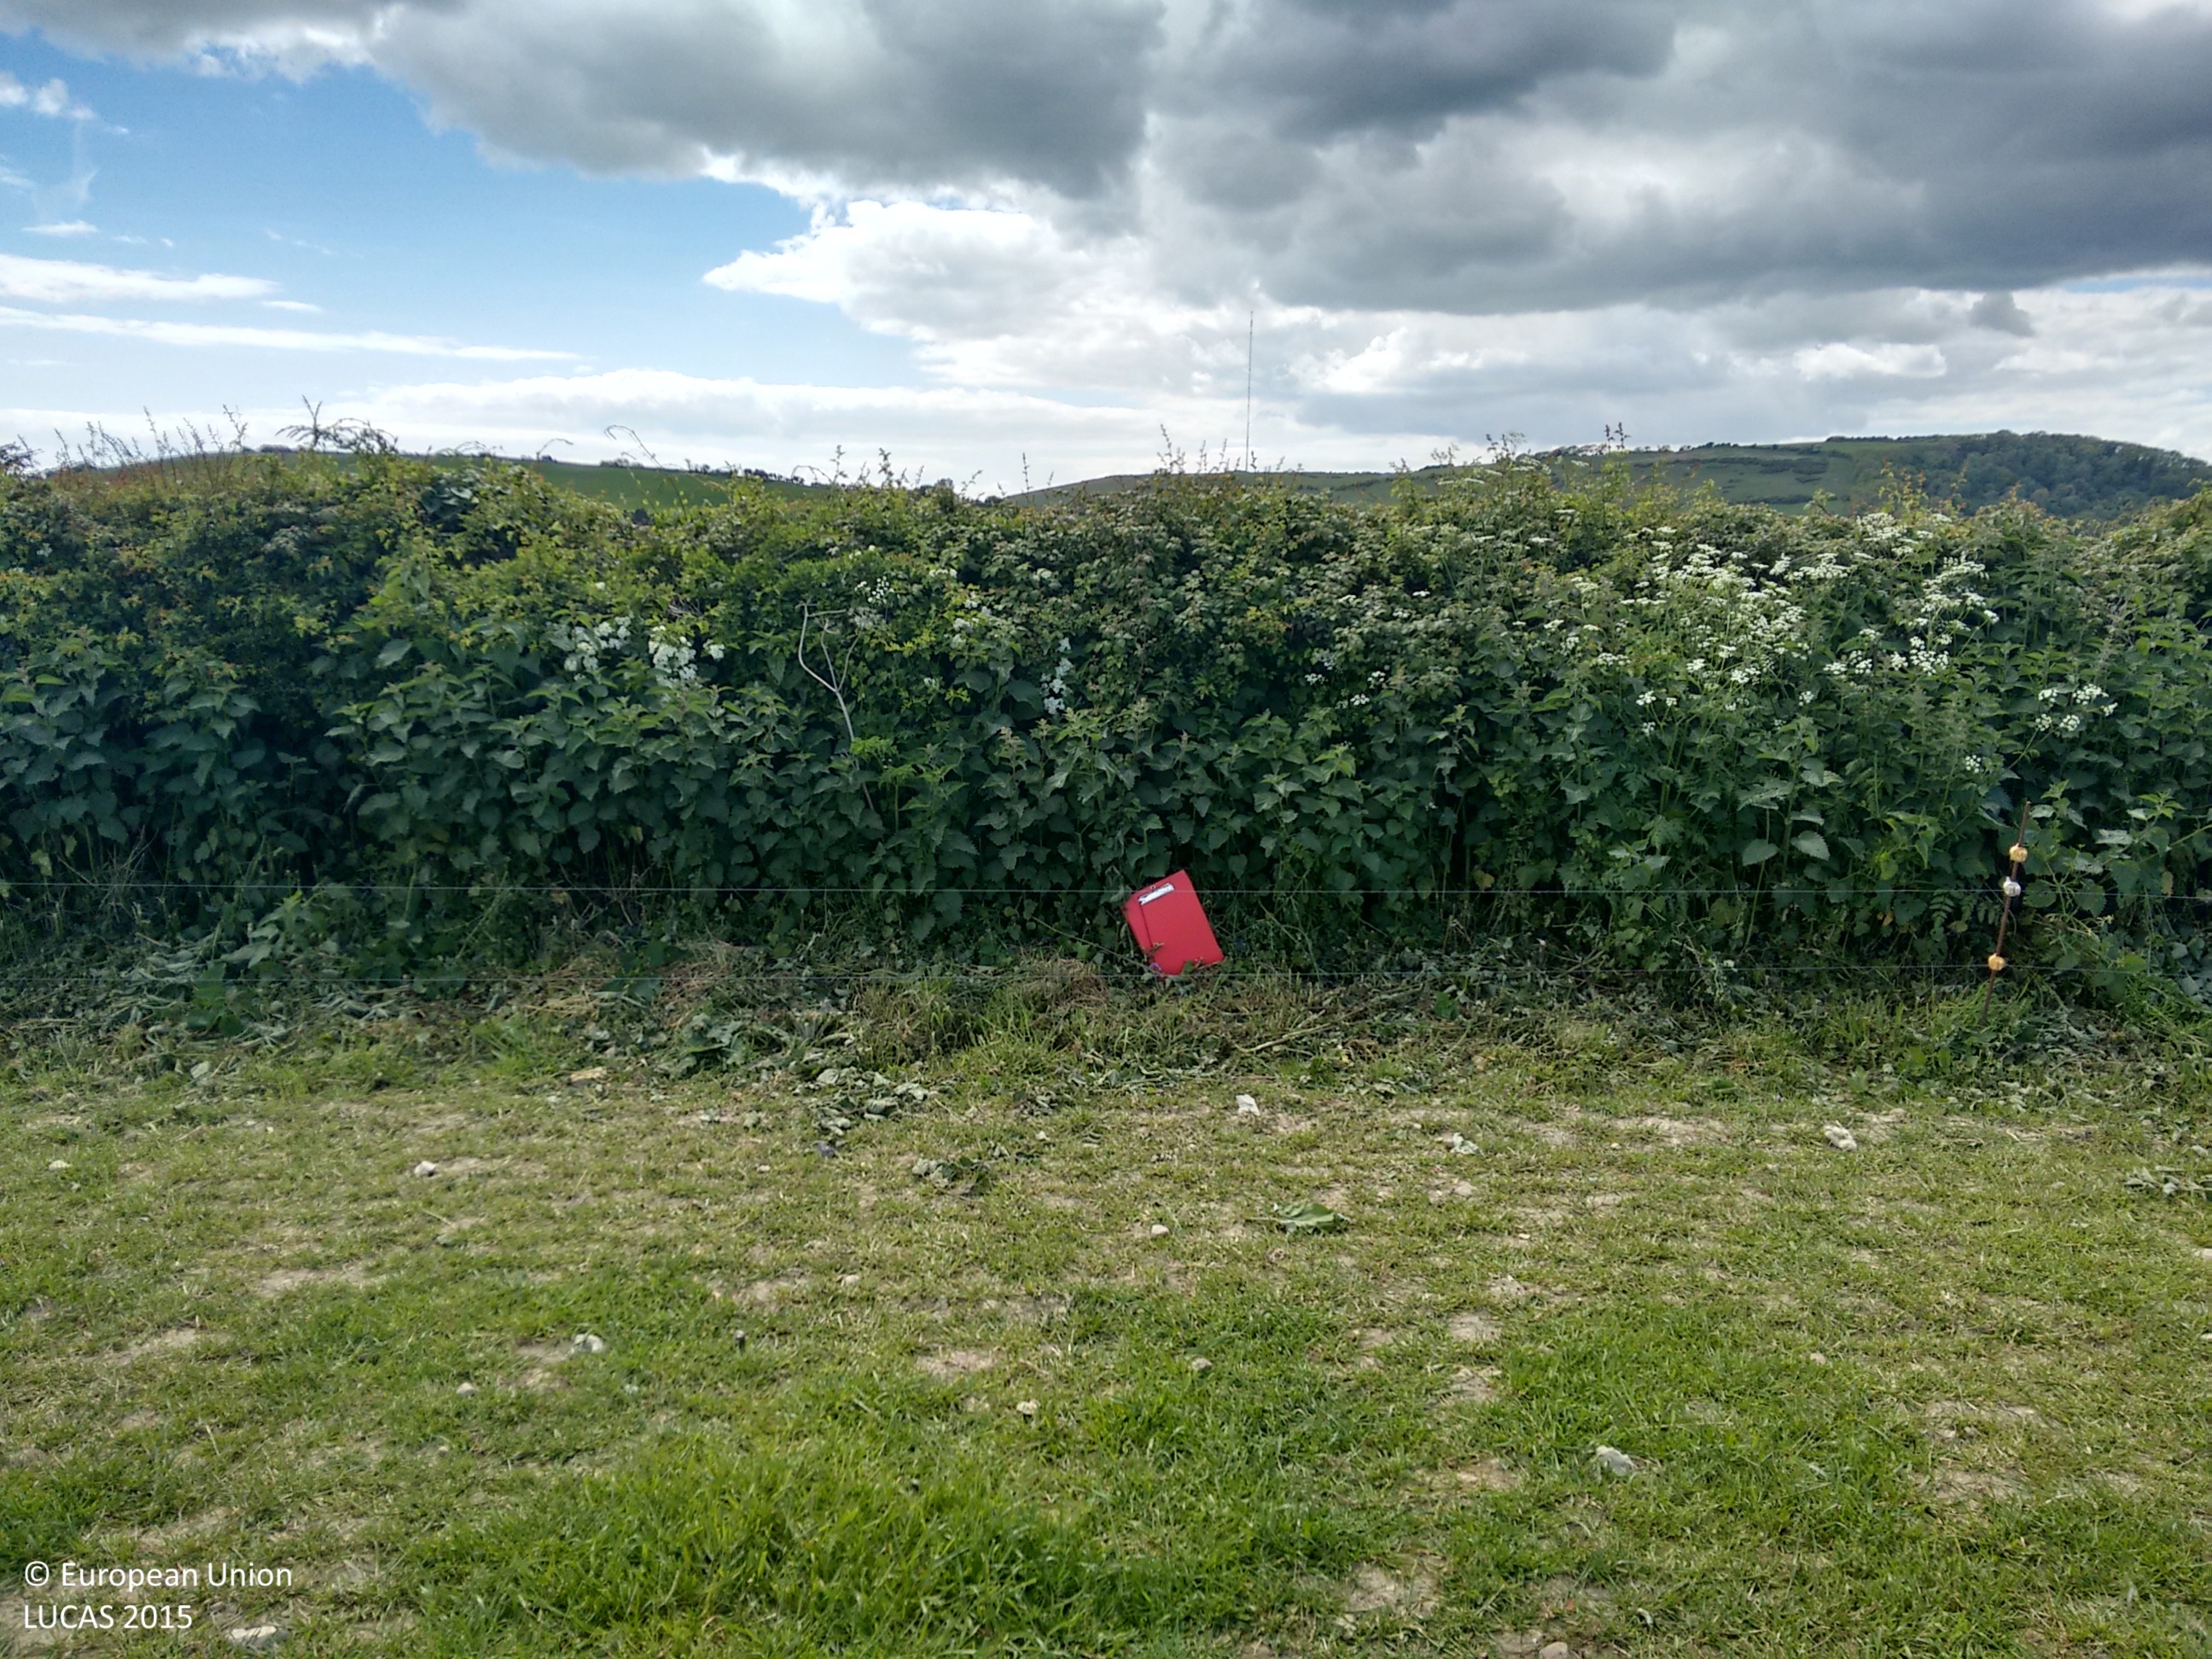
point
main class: Grassland
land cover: Grassland without tree/shrub cover
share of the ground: > 75 %
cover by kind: herbaceous plants 75 %, unconsolidated bare surface 25 %
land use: Agriculture (excluding fallow land and kitchen gardens)
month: May
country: GB
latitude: 50.6562
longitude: -1.2934
